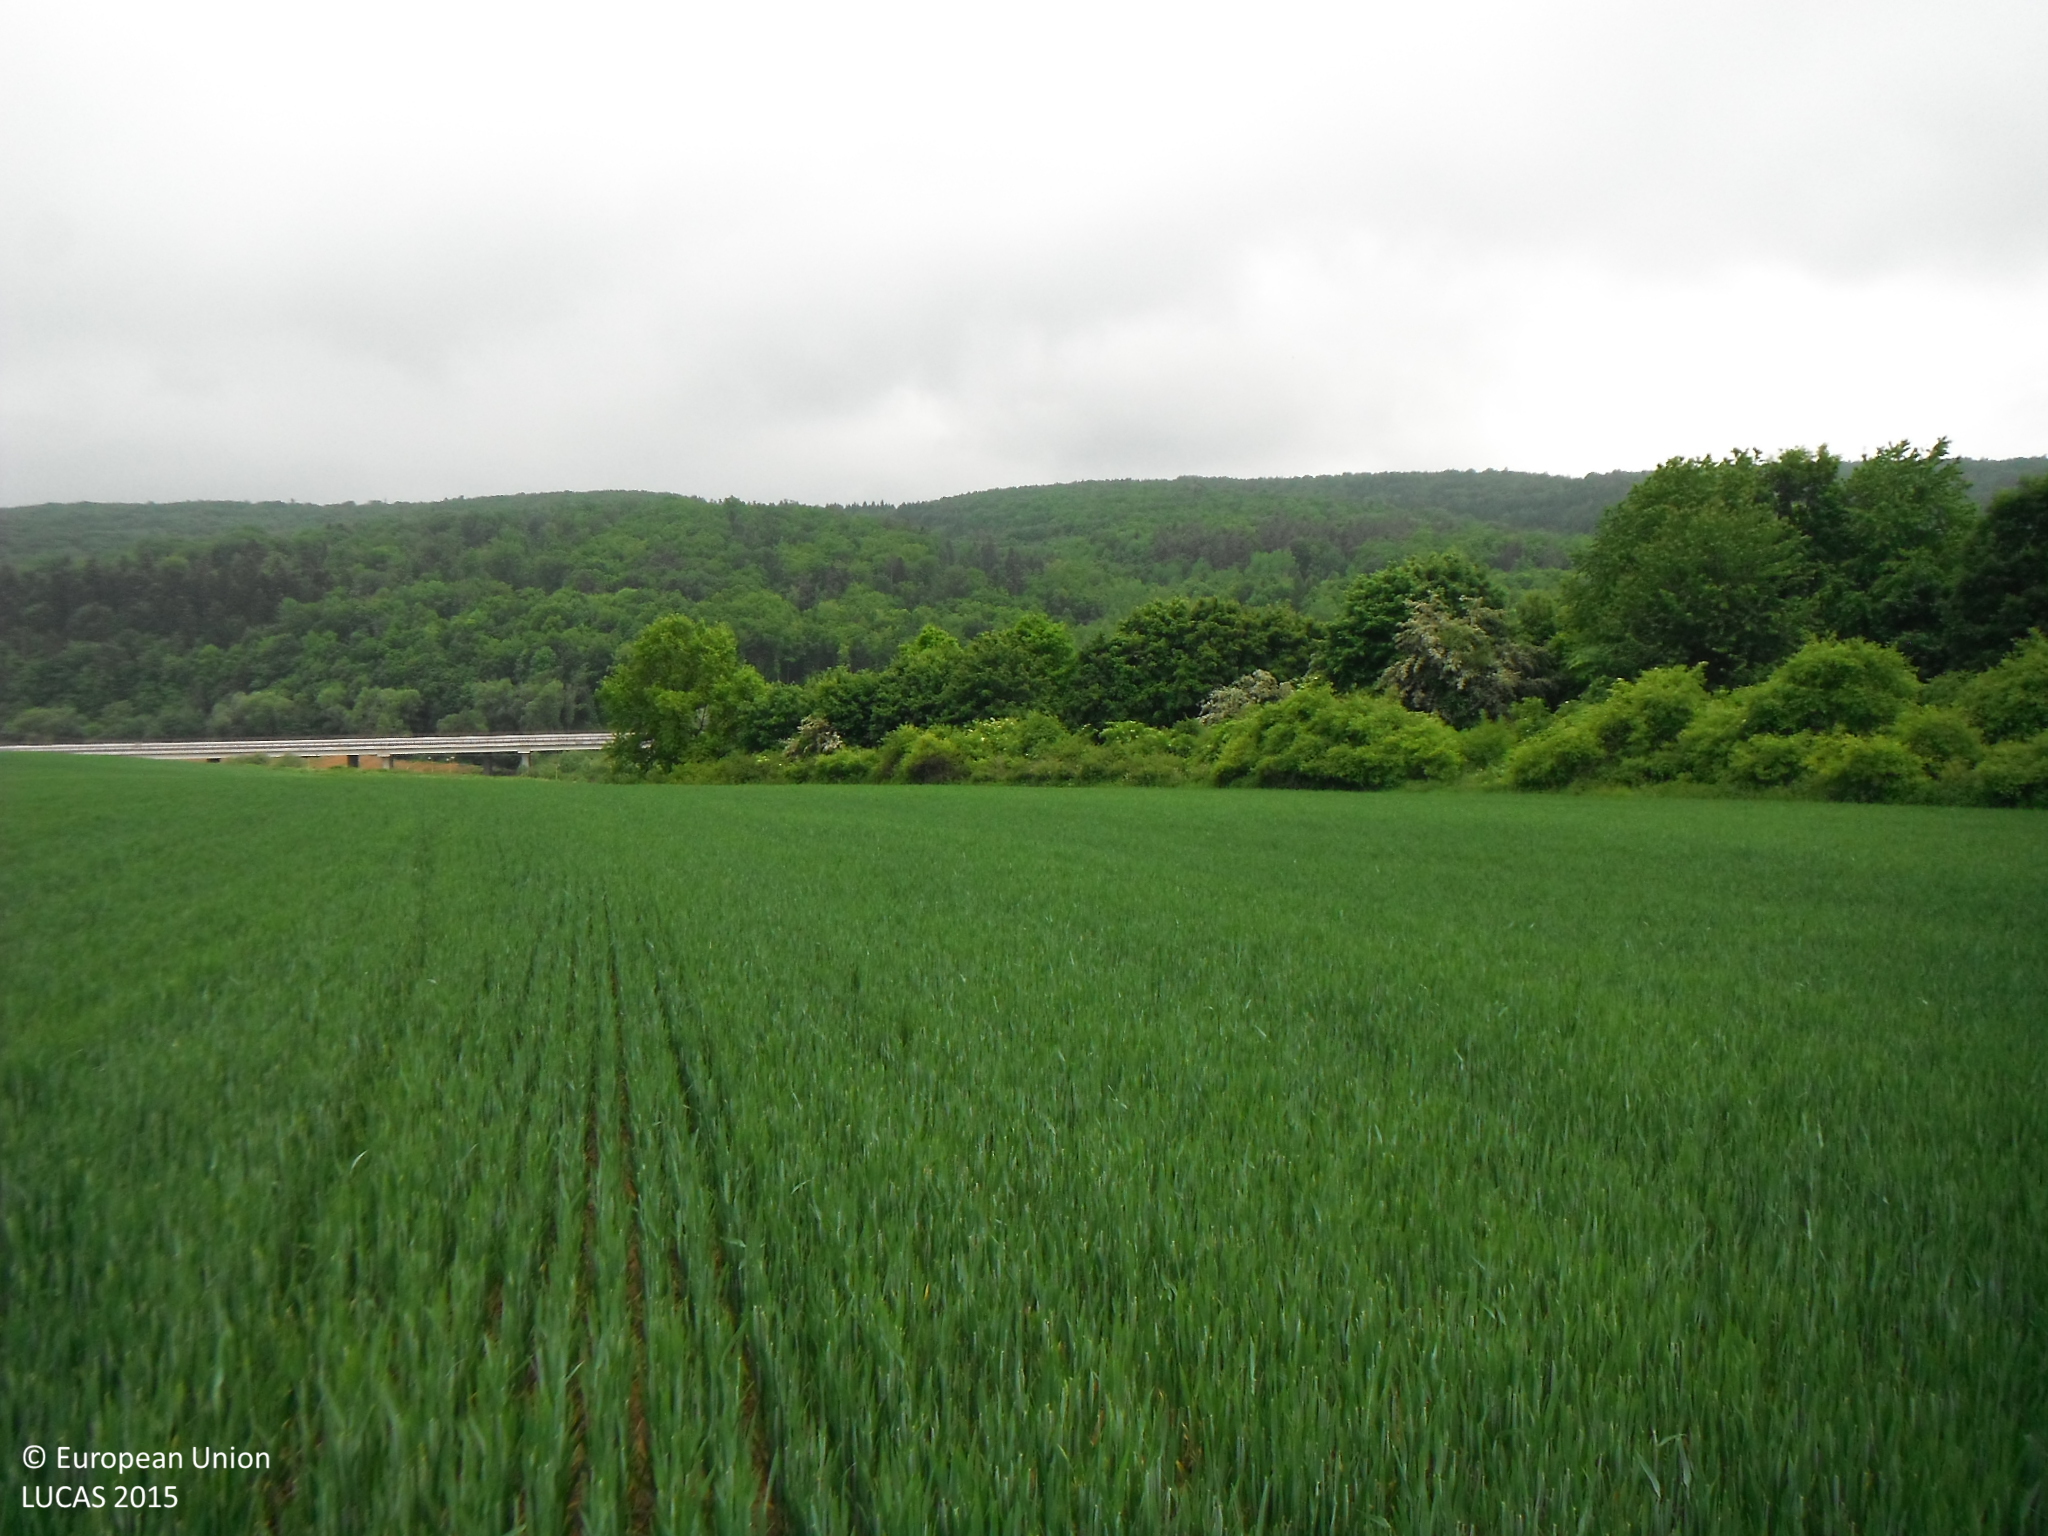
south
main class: Cropland
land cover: Common wheat
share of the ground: > 75 %
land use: Agriculture (excluding fallow land and kitchen gardens)
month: May
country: SK
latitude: 49.0047
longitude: 21.1024
